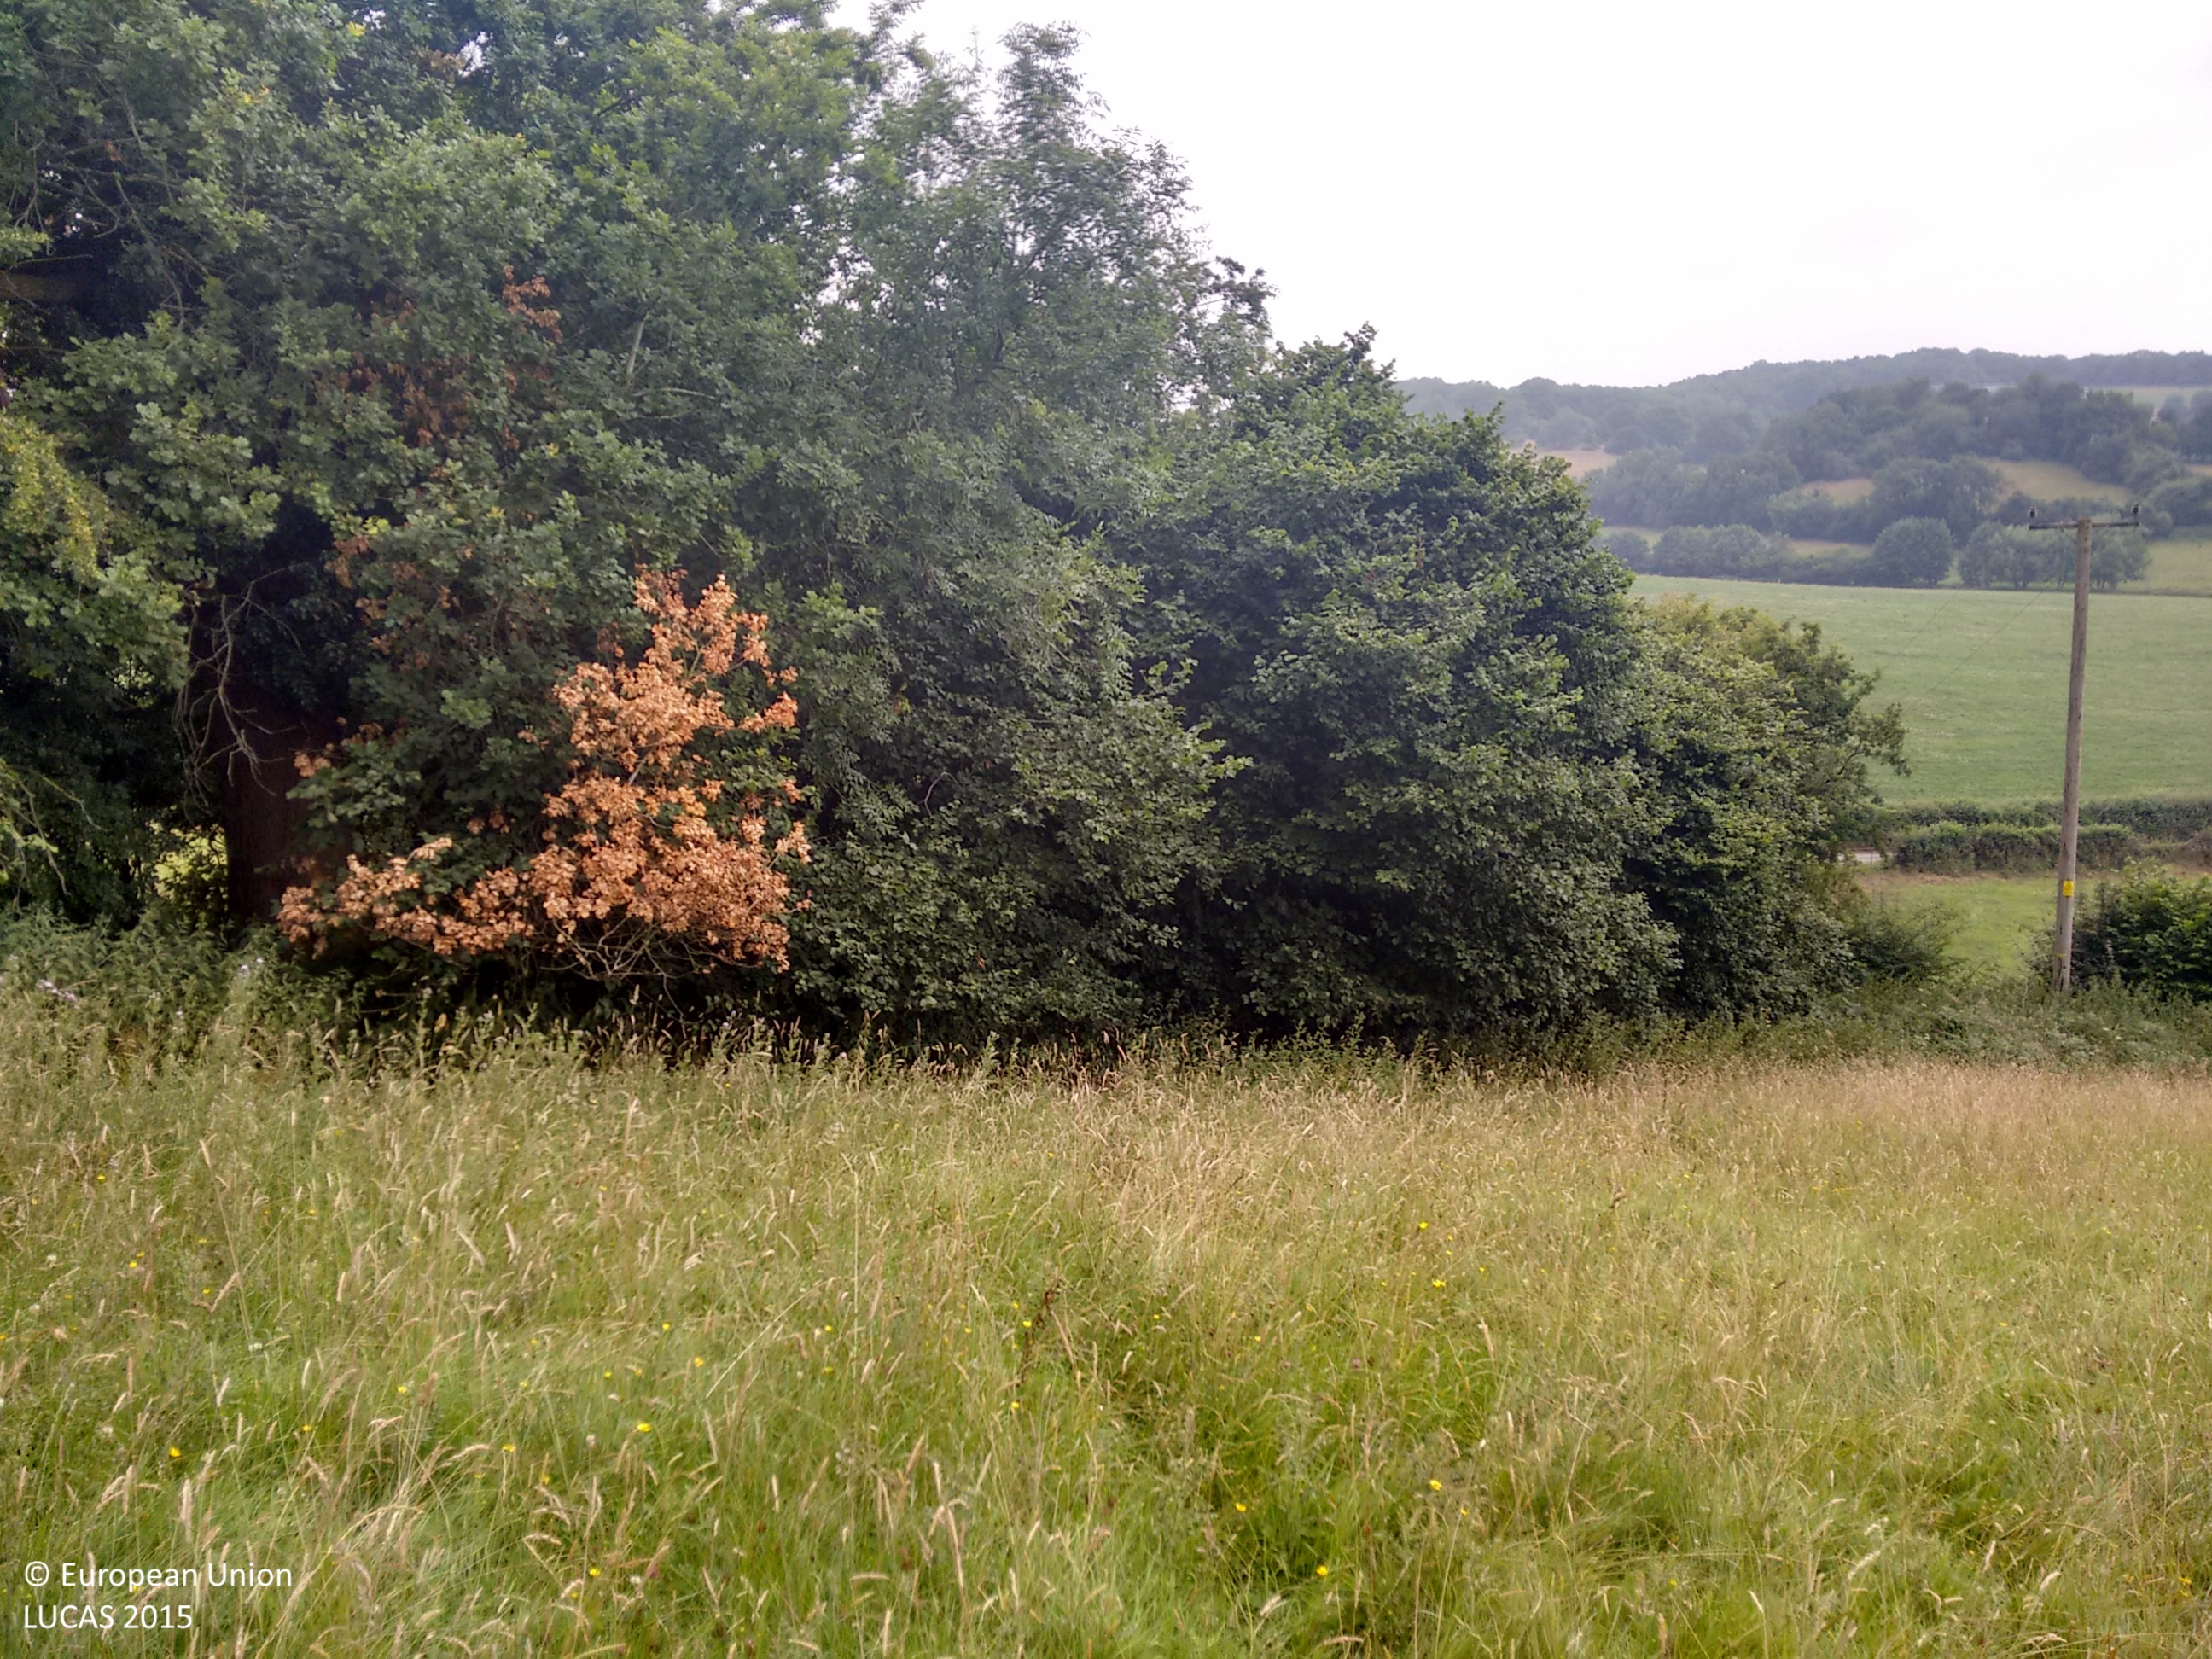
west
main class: Grassland
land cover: Grassland without tree/shrub cover
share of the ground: > 75 %
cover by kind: herbaceous plants 100 %
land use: Agriculture (excluding fallow land and kitchen gardens)
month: July
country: GB
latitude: 51.9963
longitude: -2.5788
